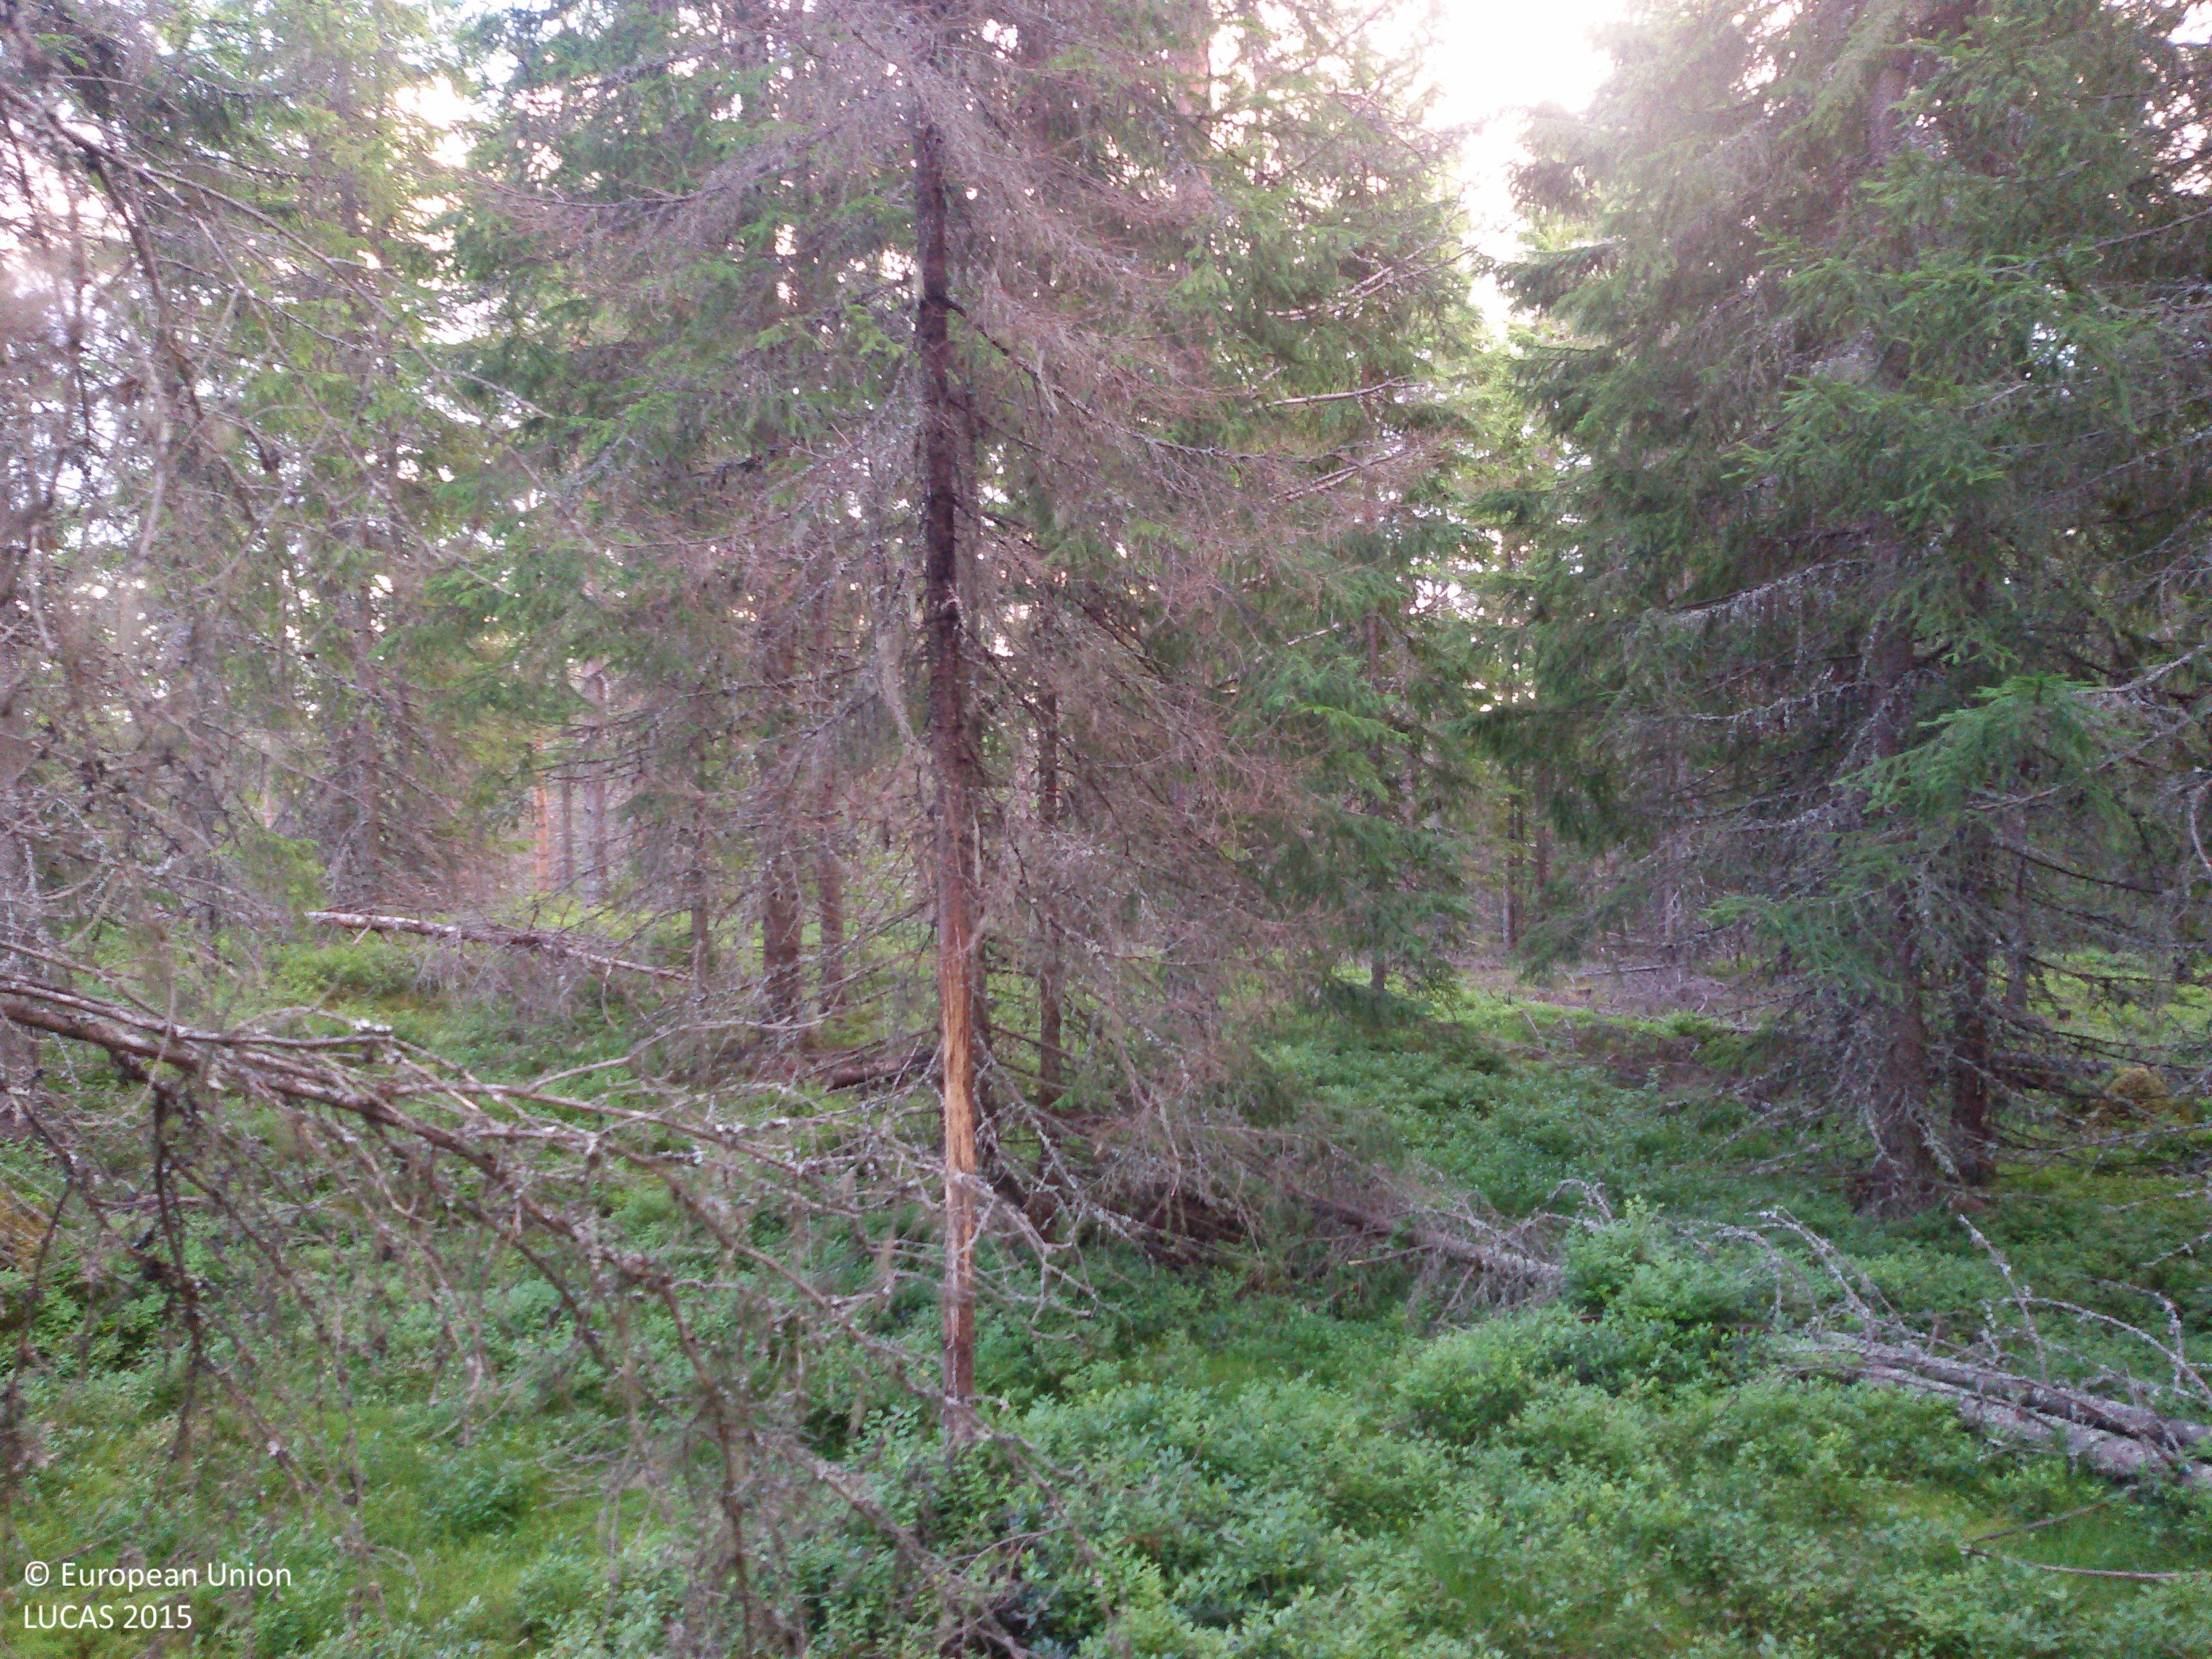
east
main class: Woodland
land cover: Spruce dominated coniferous woodland
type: boreal forest
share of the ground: 50 - 75 %
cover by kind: coniferous forest trees 70 %, herbaceous plants 30 %
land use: Forestry
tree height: > 5 m
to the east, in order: Spruce dominated coniferous woodland; Pine dominated coniferous woodland; Ditches and canals; Paved roads, cycling and walking lanes; Grass margins; Ditches and canals; Pine dominated mixed woodland
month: July
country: SE
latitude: 60.5623
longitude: 14.9673
